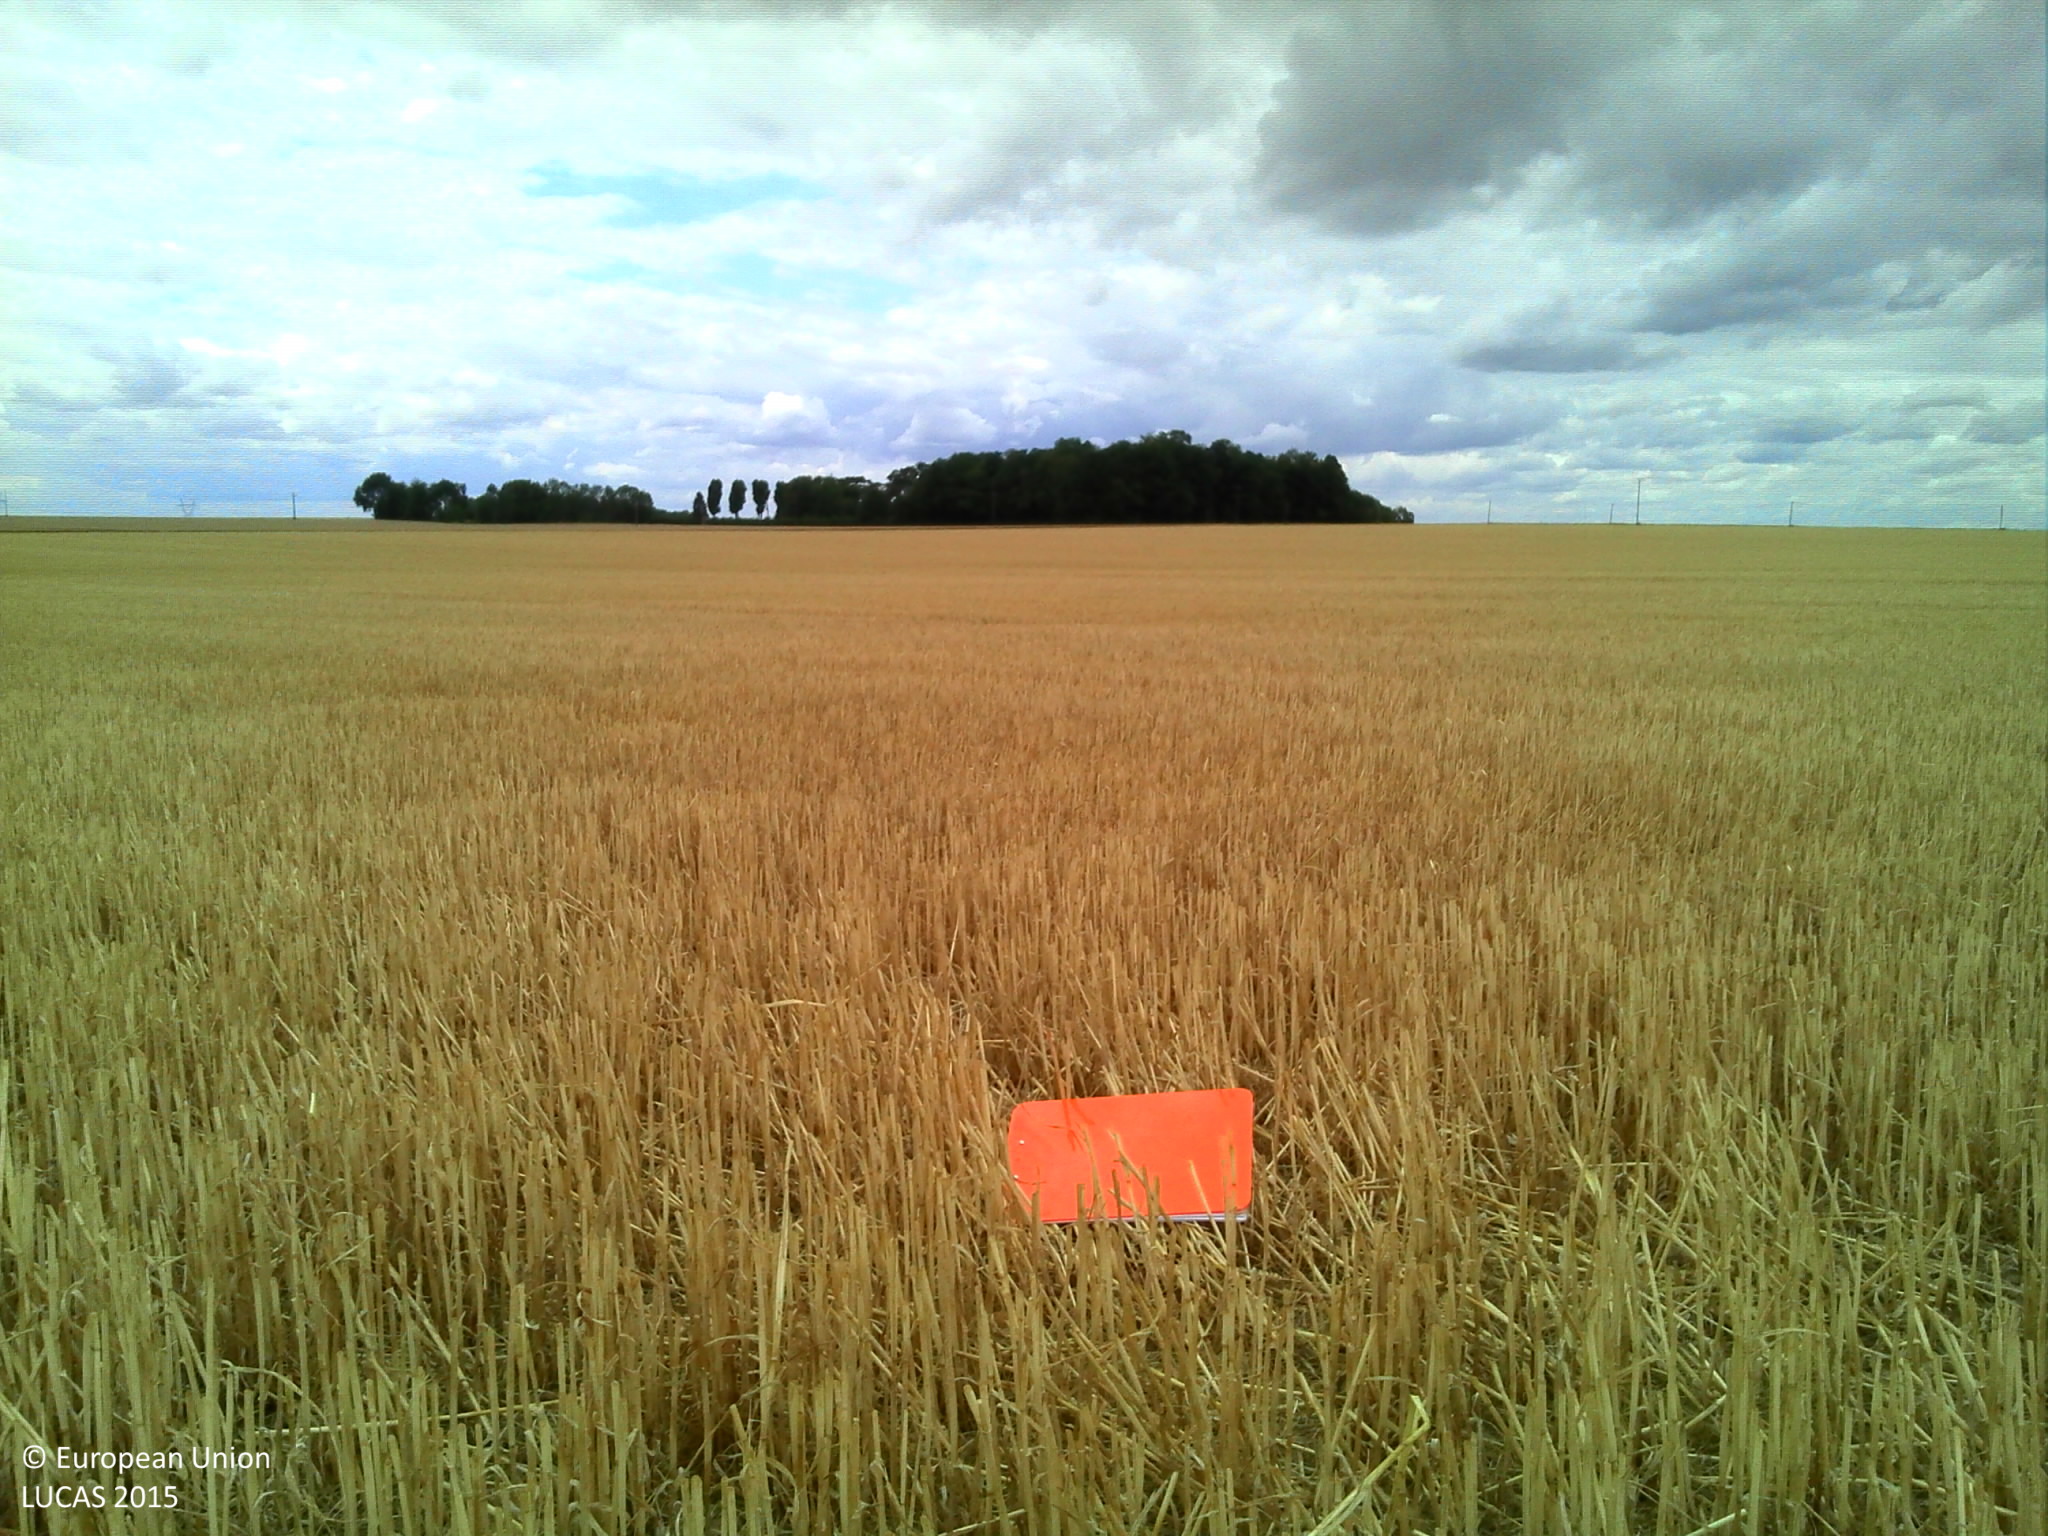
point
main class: Cropland
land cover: Common wheat
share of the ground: > 75 %
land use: Agriculture (excluding fallow land and kitchen gardens)
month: July
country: FR
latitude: 48.7671
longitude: 3.4219
